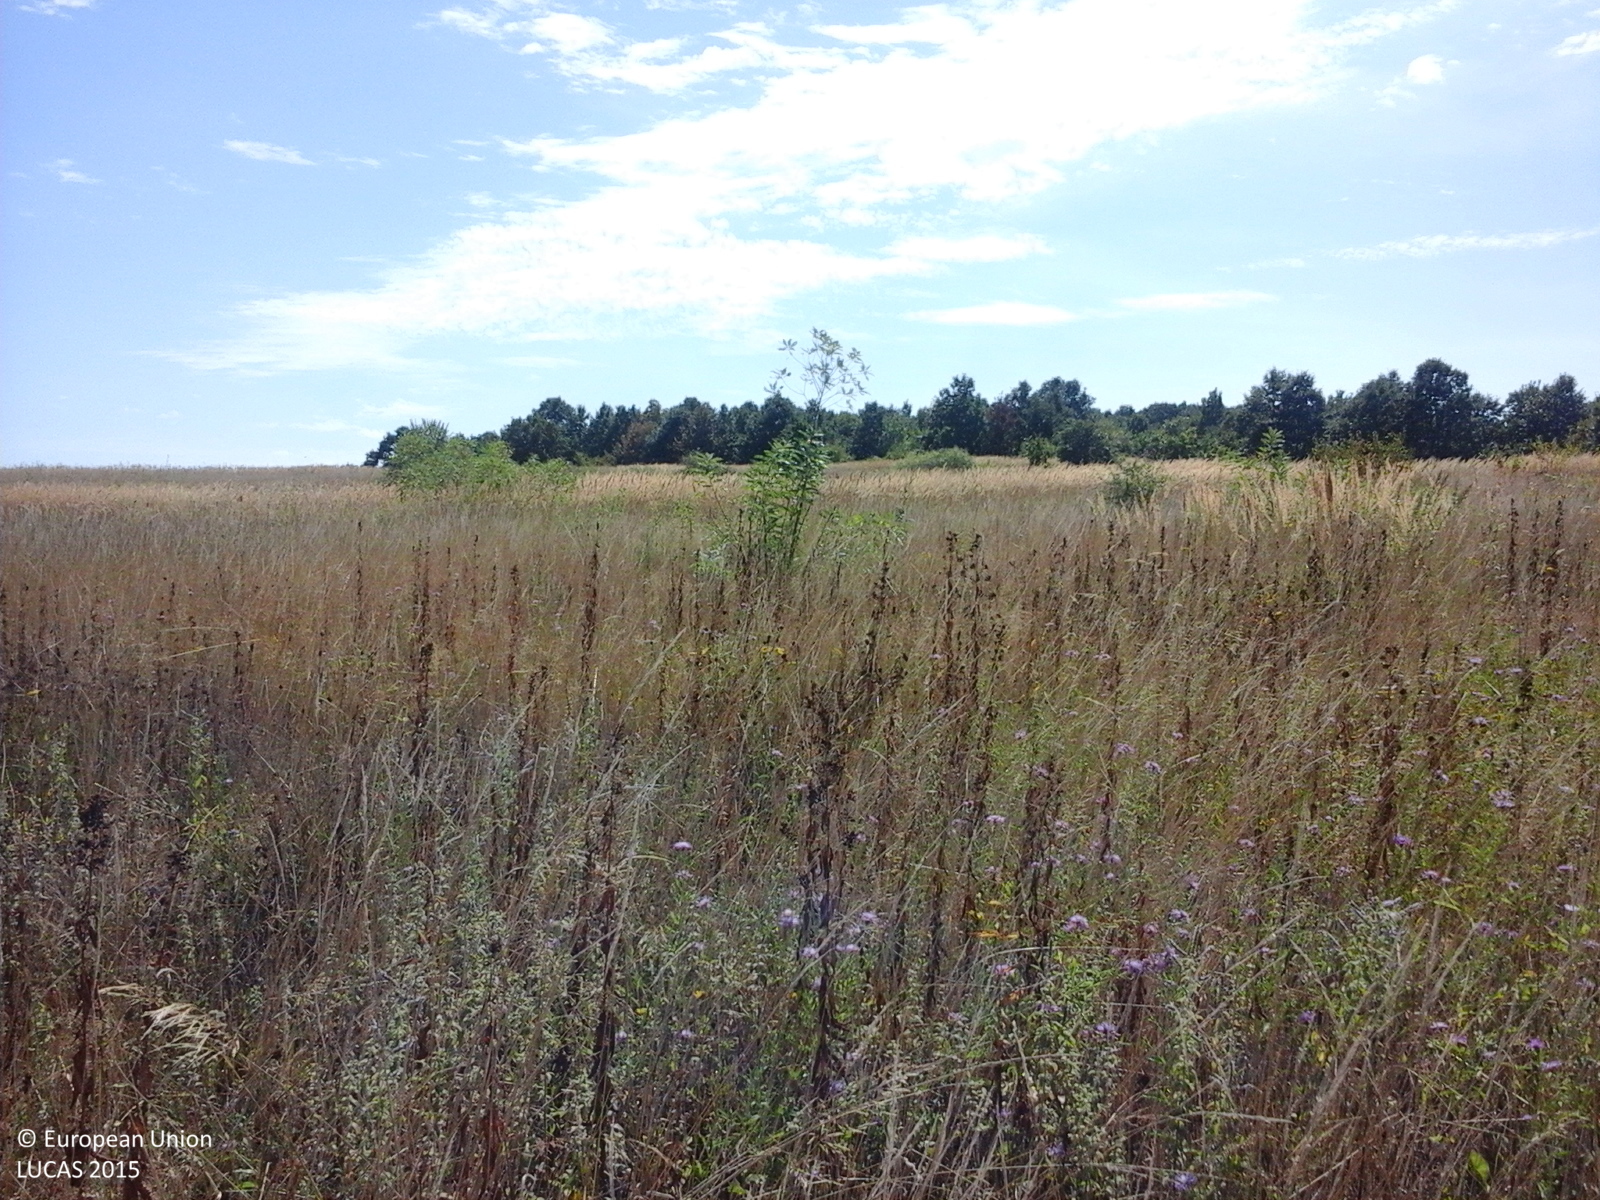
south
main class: Grassland
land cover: Spontaneously vegetated surfaces
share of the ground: > 75 %
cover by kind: herbaceous plants 100 %
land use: Agriculture (excluding fallow land and kitchen gardens)
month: August
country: RO
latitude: 45.3472
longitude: 21.6605
